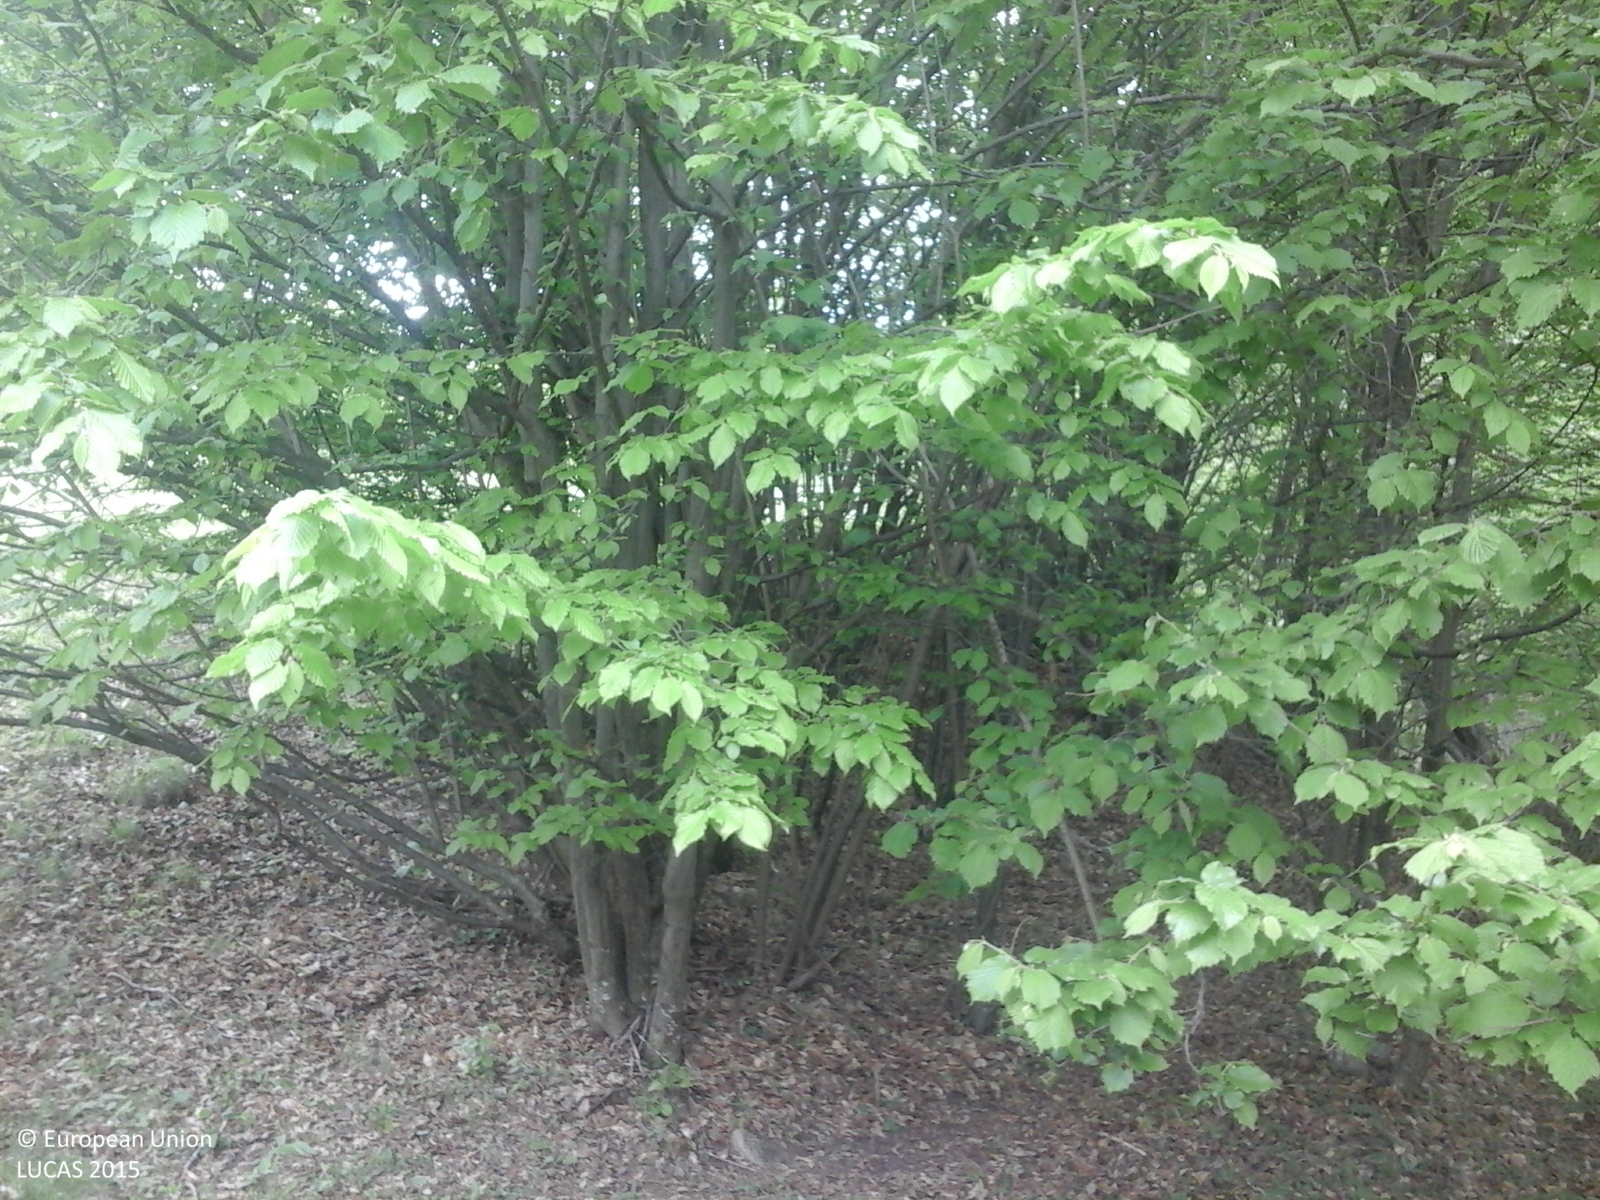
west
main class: Woodland
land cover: Broadleaved woodland
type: beech forest
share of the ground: > 75 %
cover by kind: broadleaved forest trees 100 %
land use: Forestry
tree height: > 5 m
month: May
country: RO
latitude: 45.5900
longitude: 25.9162
